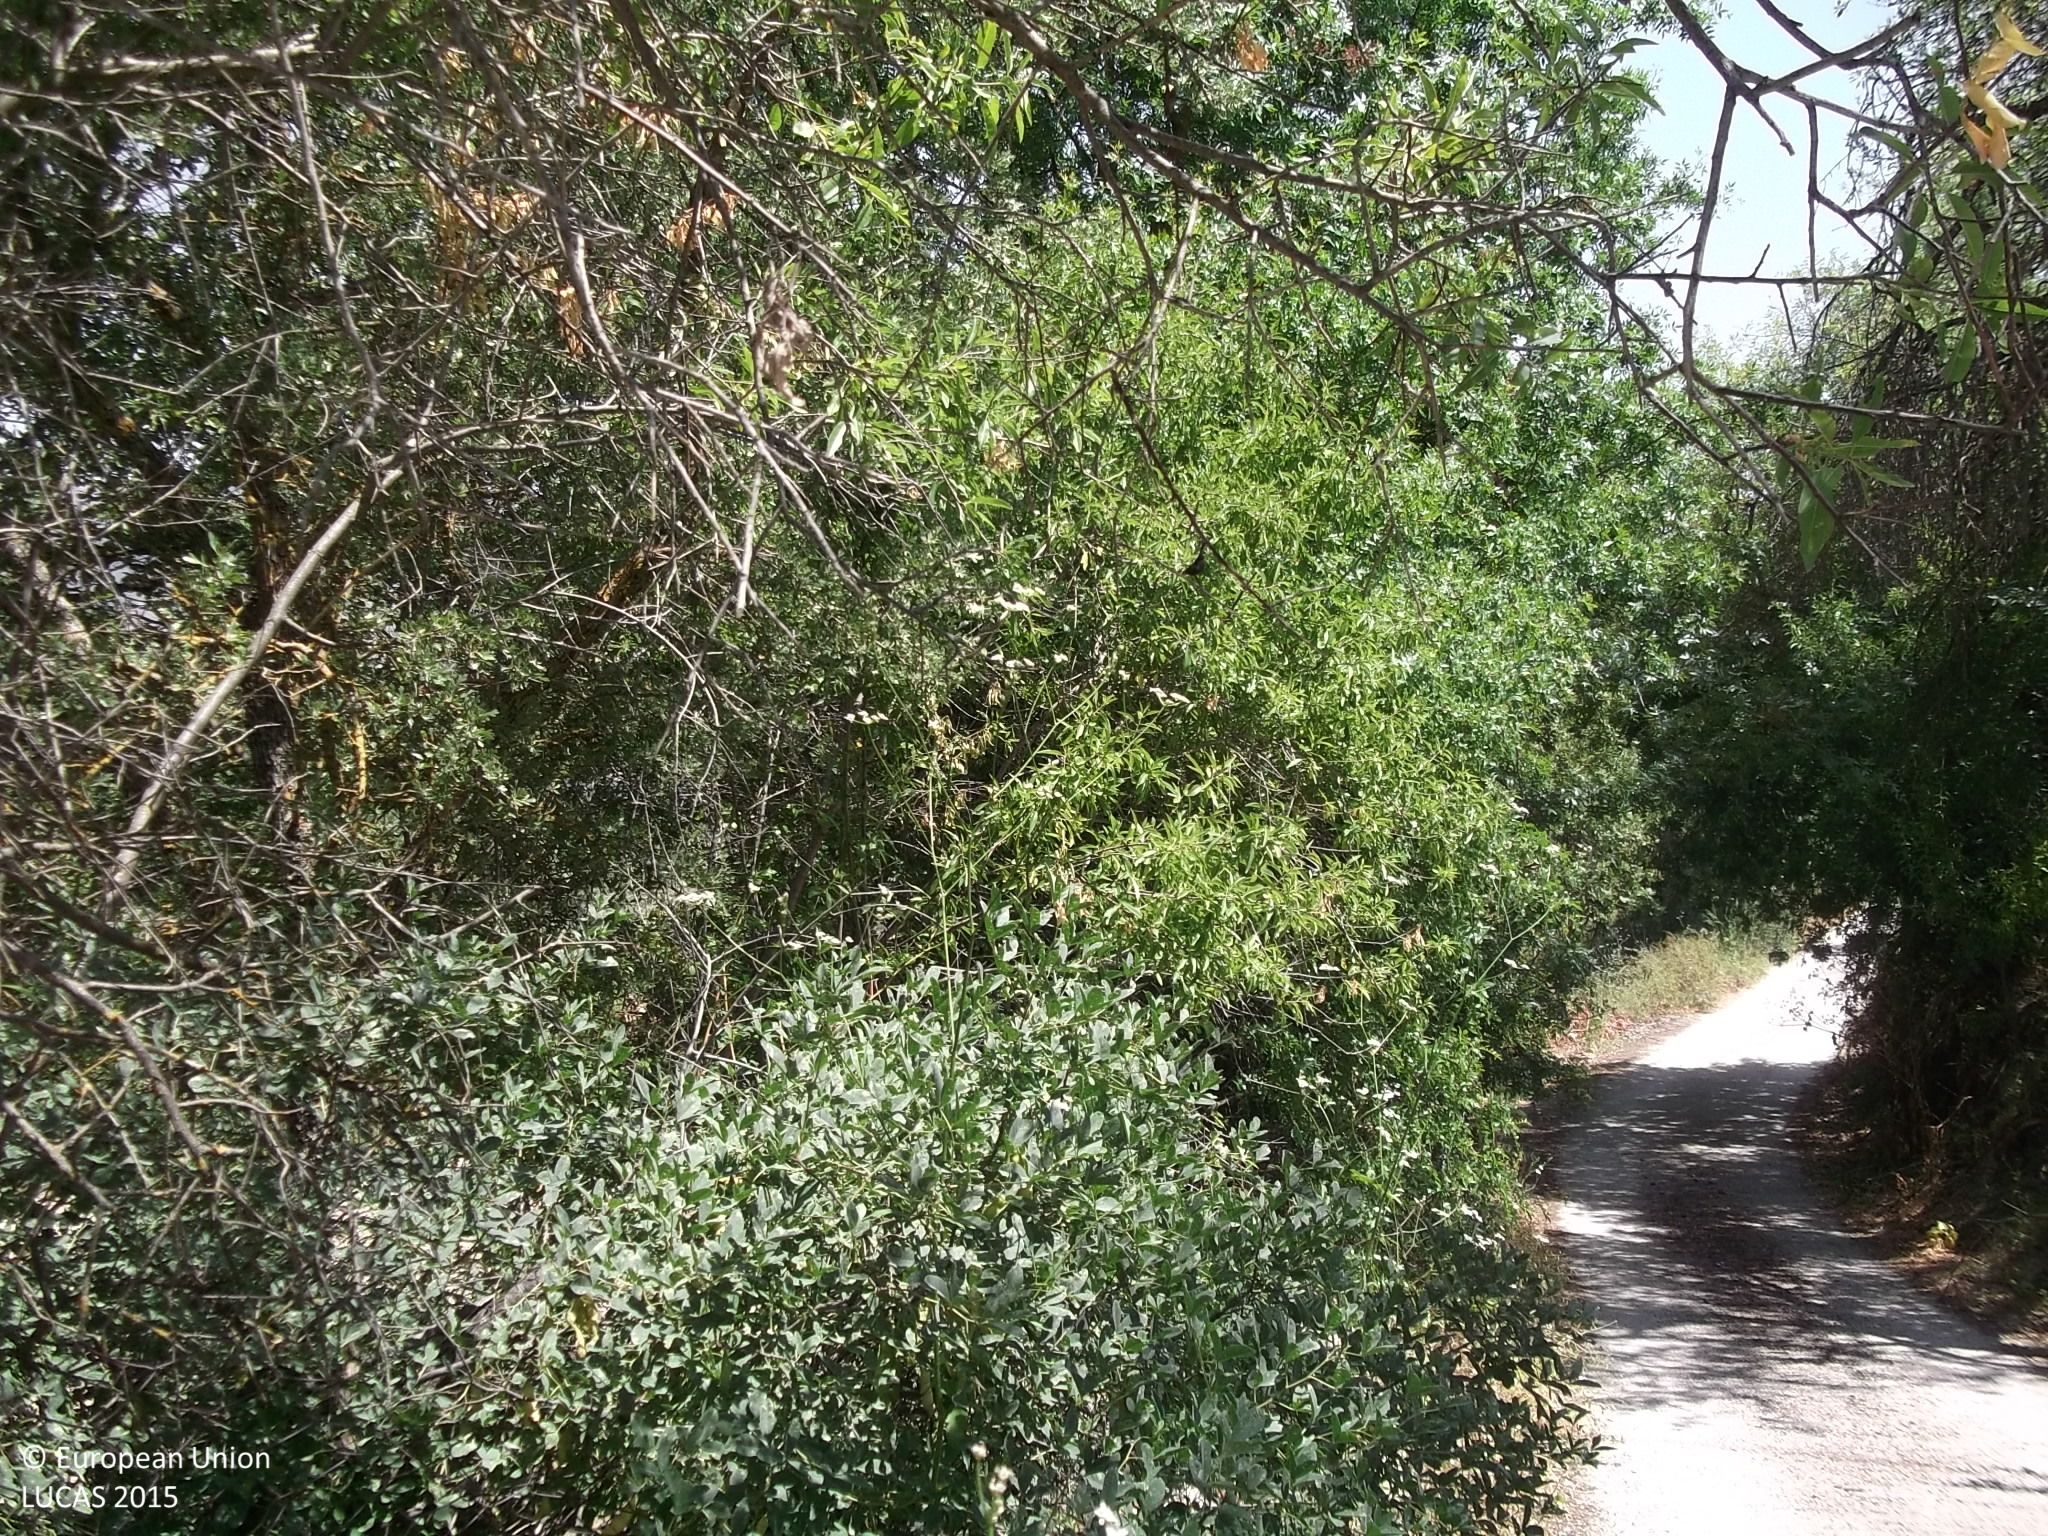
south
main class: Cropland
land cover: Nuts trees
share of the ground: 50 - 75 %
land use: Agriculture (excluding fallow land and kitchen gardens)
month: May
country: CY
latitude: 34.9235
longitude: 32.5623
